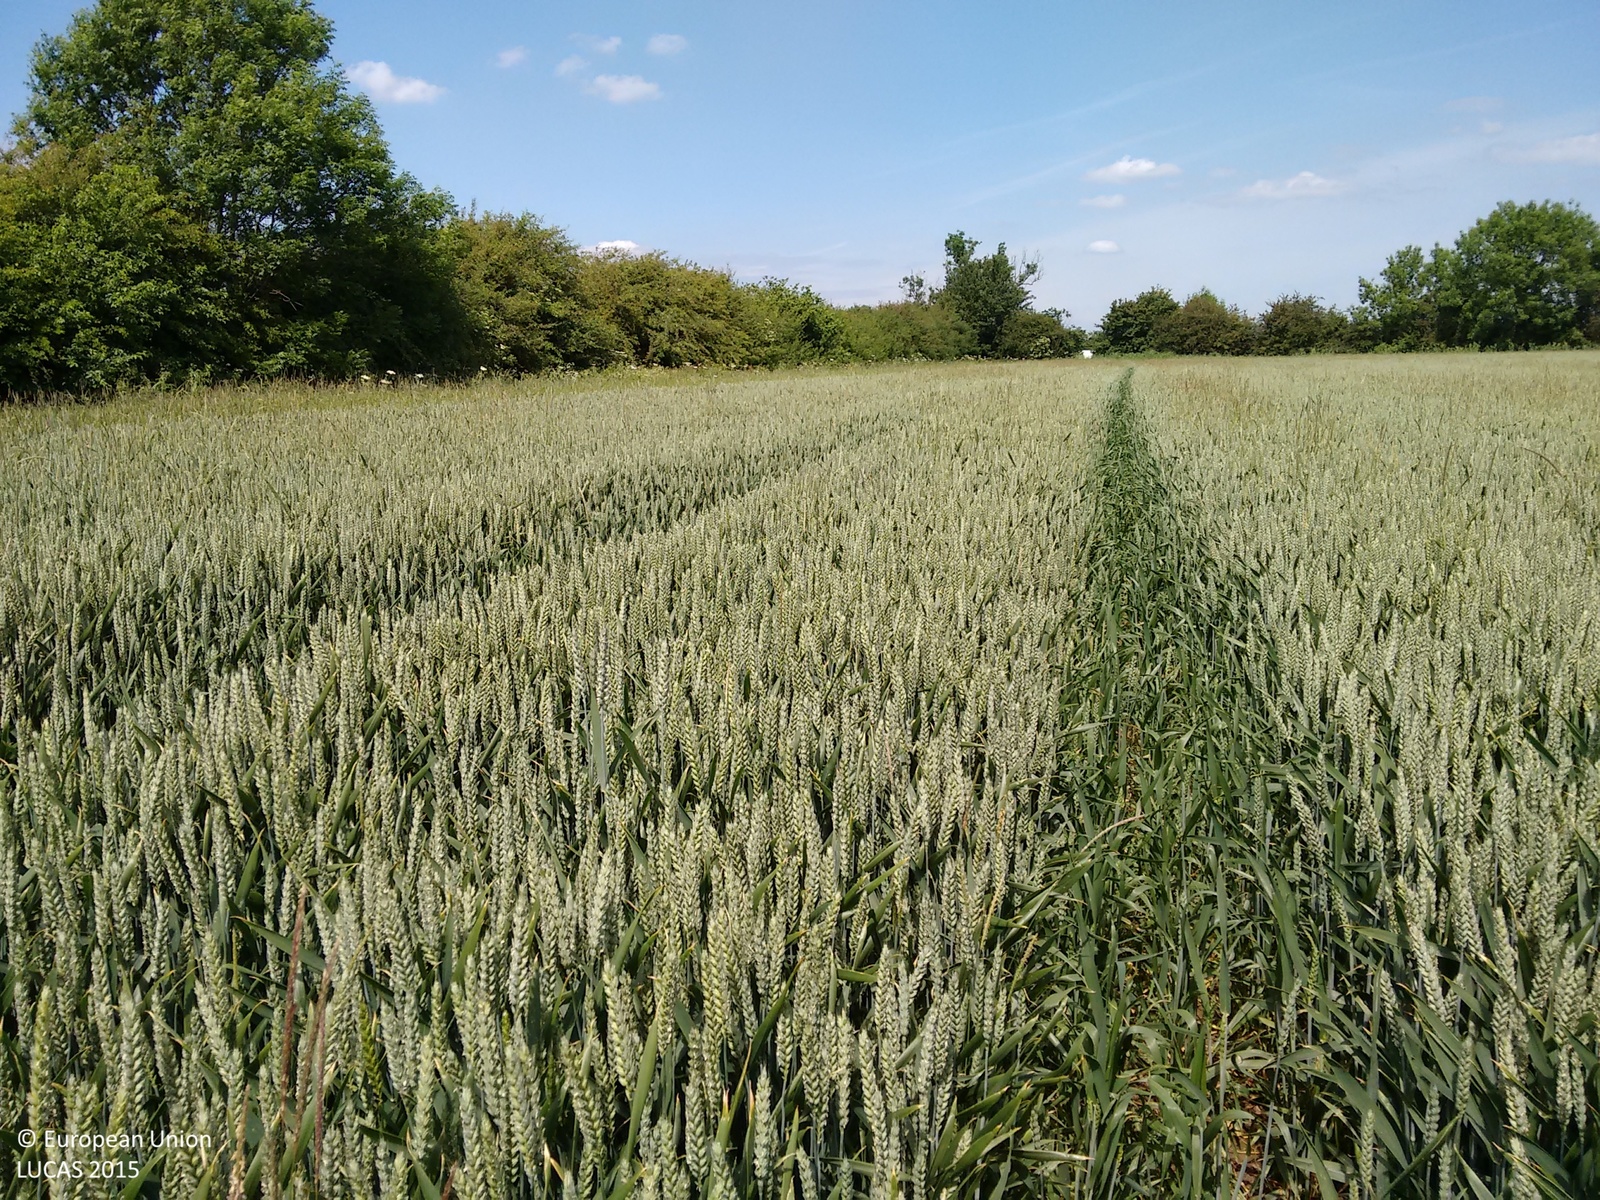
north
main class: Cropland
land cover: Common wheat
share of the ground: > 75 %
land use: Agriculture (excluding fallow land and kitchen gardens)
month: June
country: GB
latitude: 53.0962
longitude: -0.6272
